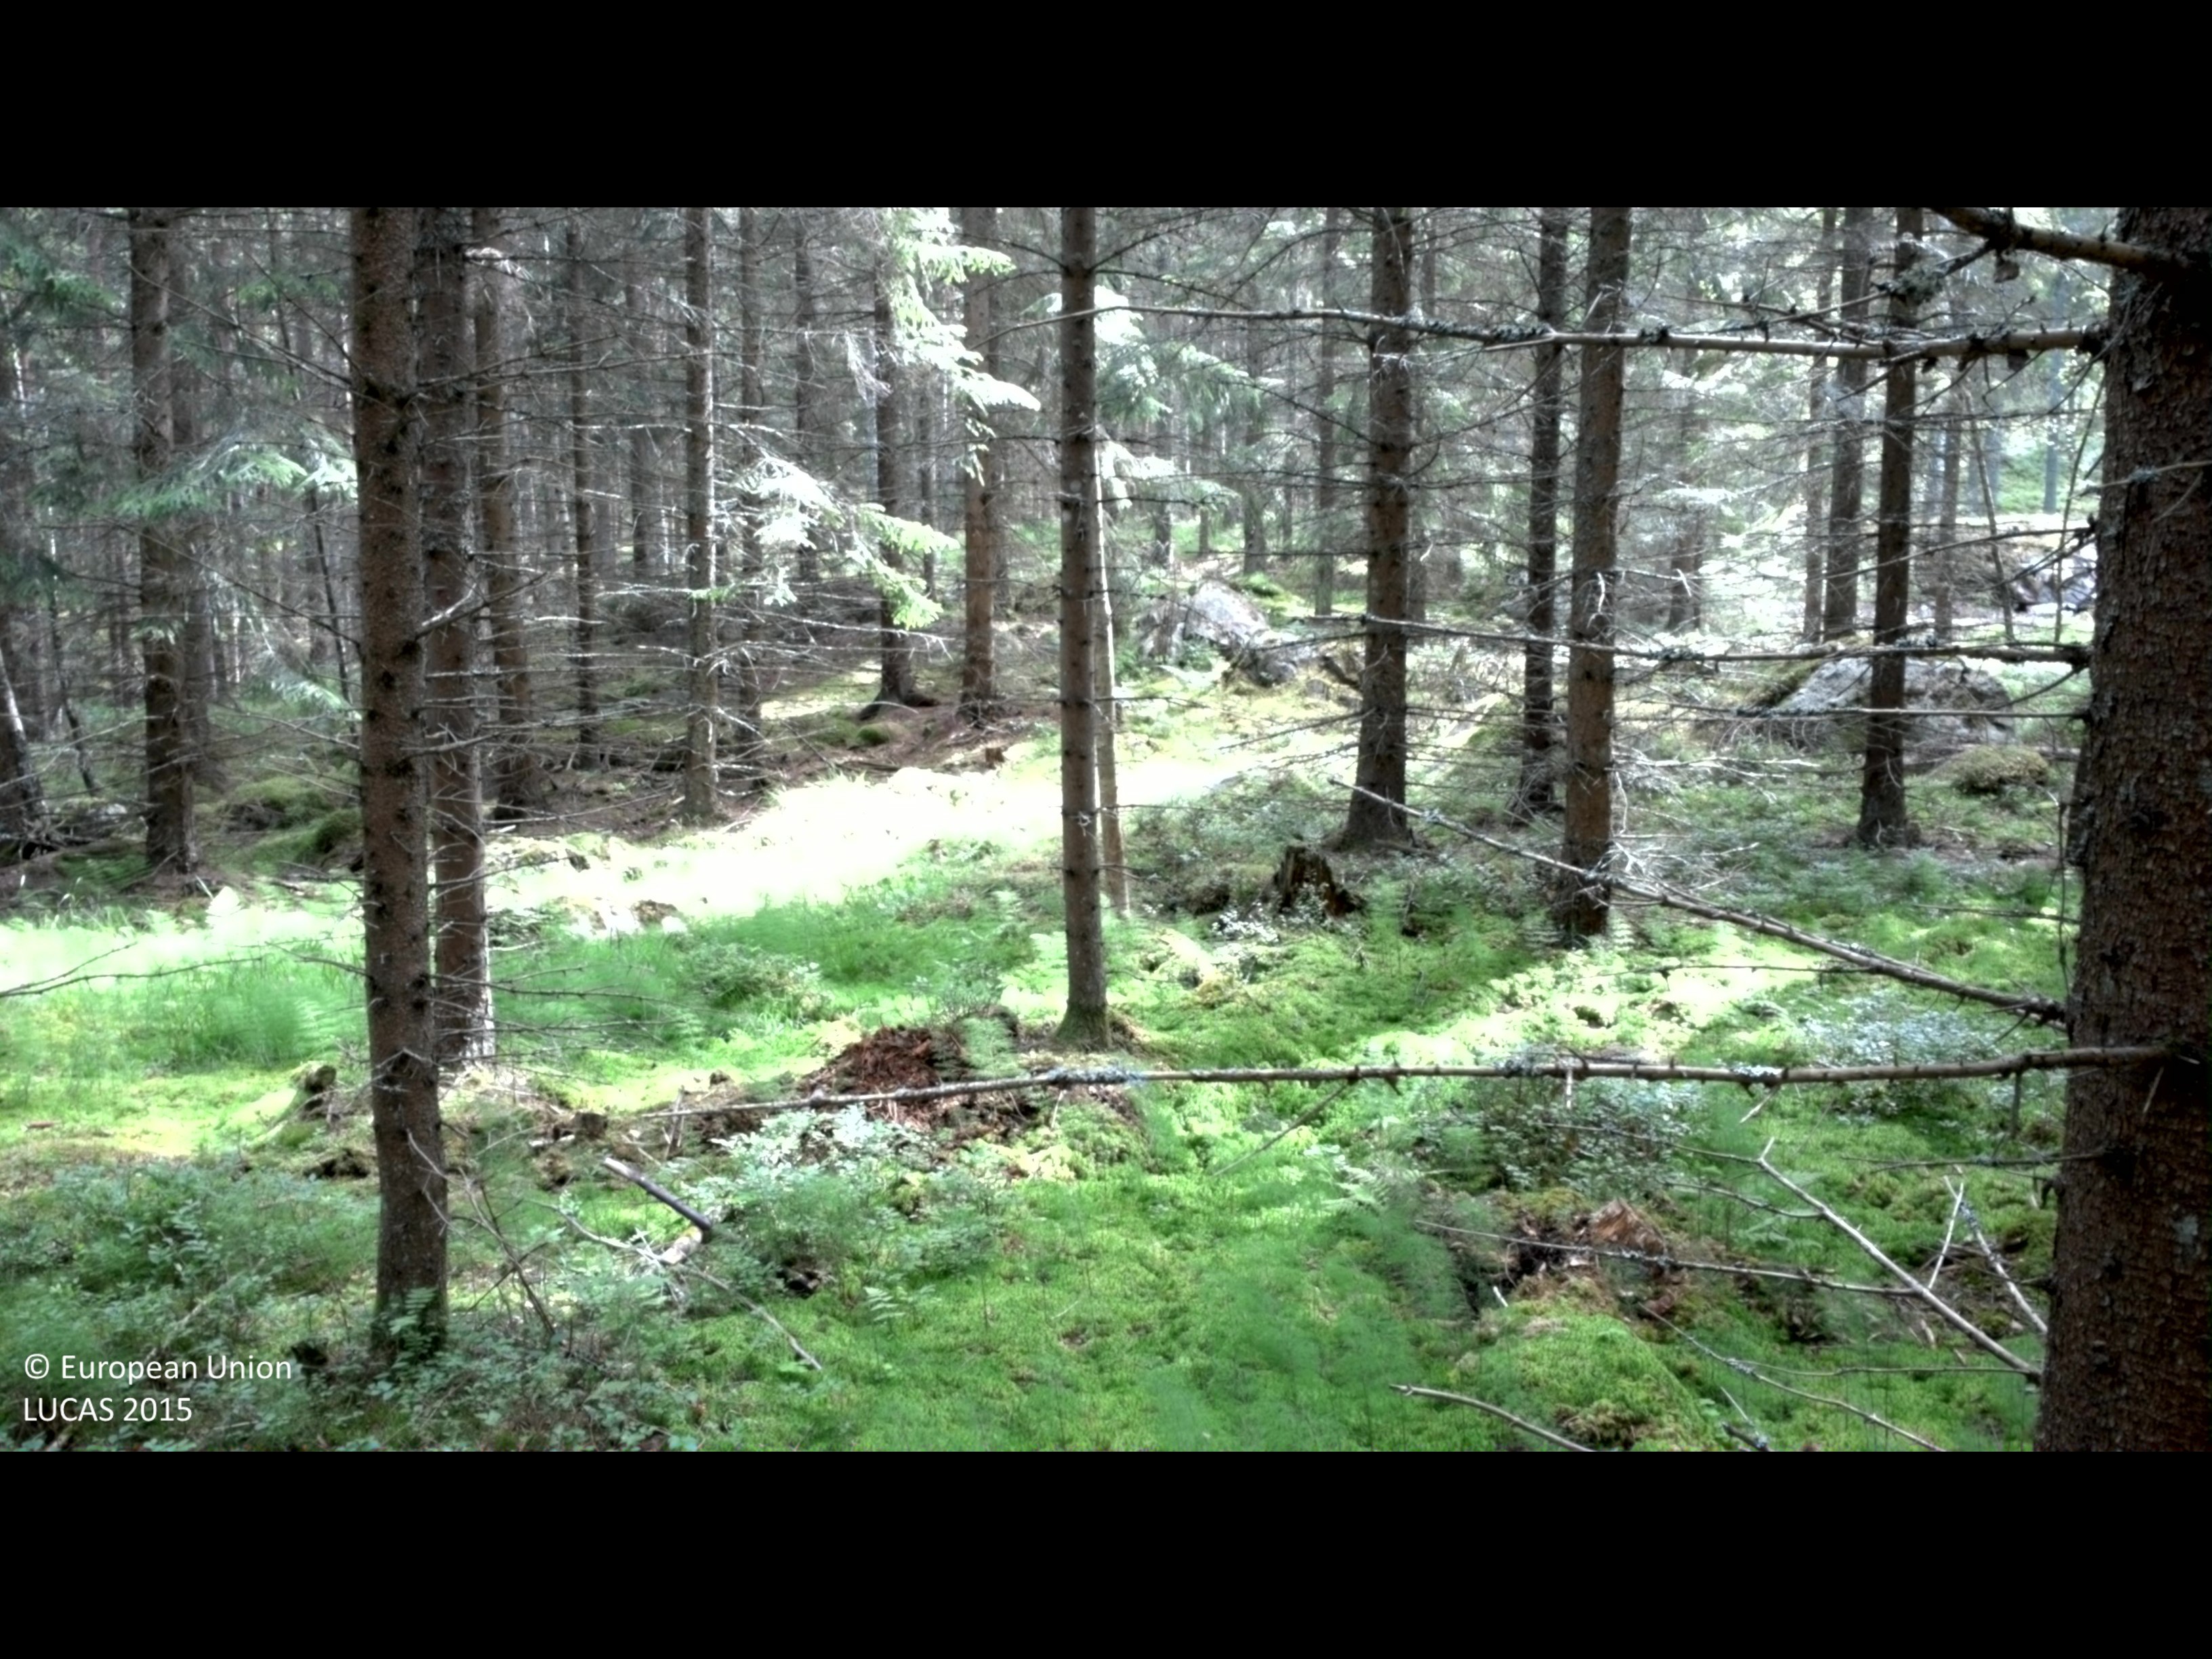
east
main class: Woodland
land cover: Spruce dominated coniferous woodland
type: boreal forest
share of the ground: > 75 %
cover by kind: coniferous forest trees 70 %, broadleaved forest trees 15 %, lichens and mosses 10 %, shrubs 5 %
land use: Forestry
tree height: > 5 m
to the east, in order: Spruce dominated coniferous woodland; Pine dominated coniferous woodland; Spruce dominated coniferous woodland; Pine dominated coniferous woodland; Spruce dominated coniferous woodland
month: June
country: SE
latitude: 58.2430
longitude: 16.1115
